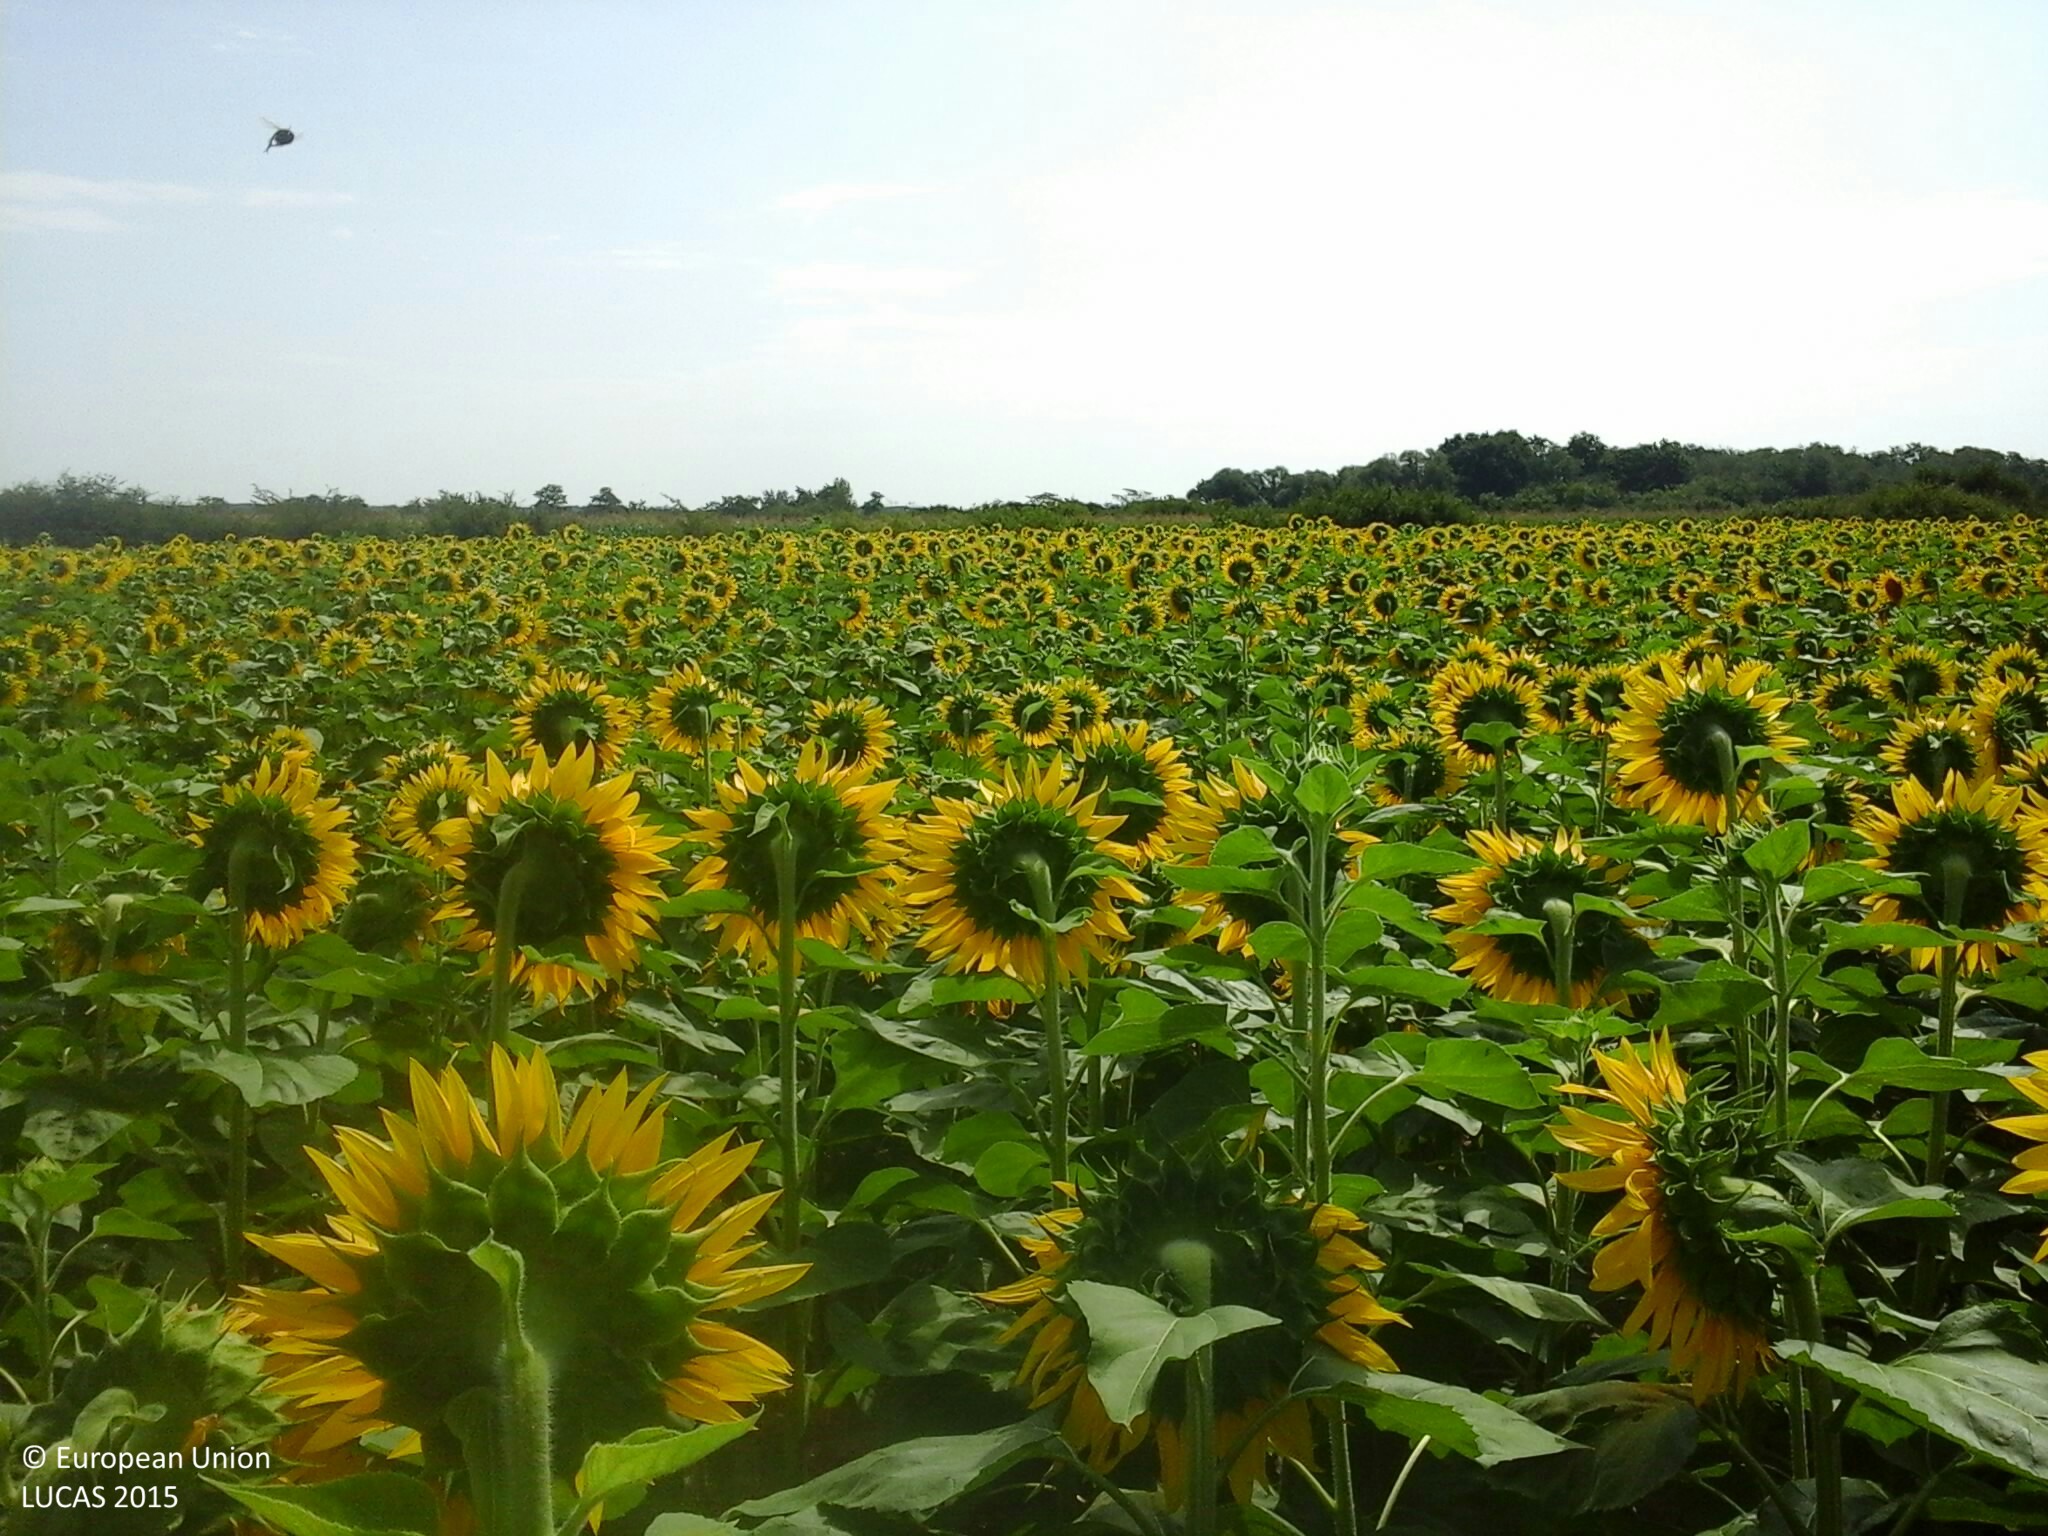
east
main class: Cropland
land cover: Sunflower
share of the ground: > 75 %
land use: Agriculture (excluding fallow land and kitchen gardens)
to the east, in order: Sunflower; Tracks; Abandoned hedges; Ditches and canals; Maize; Shrubland with sparse tree cover; Ditches and canals; Shrubland with sparse tree cover; Sunflower
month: July
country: HU
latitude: 47.0344
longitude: 16.5695
